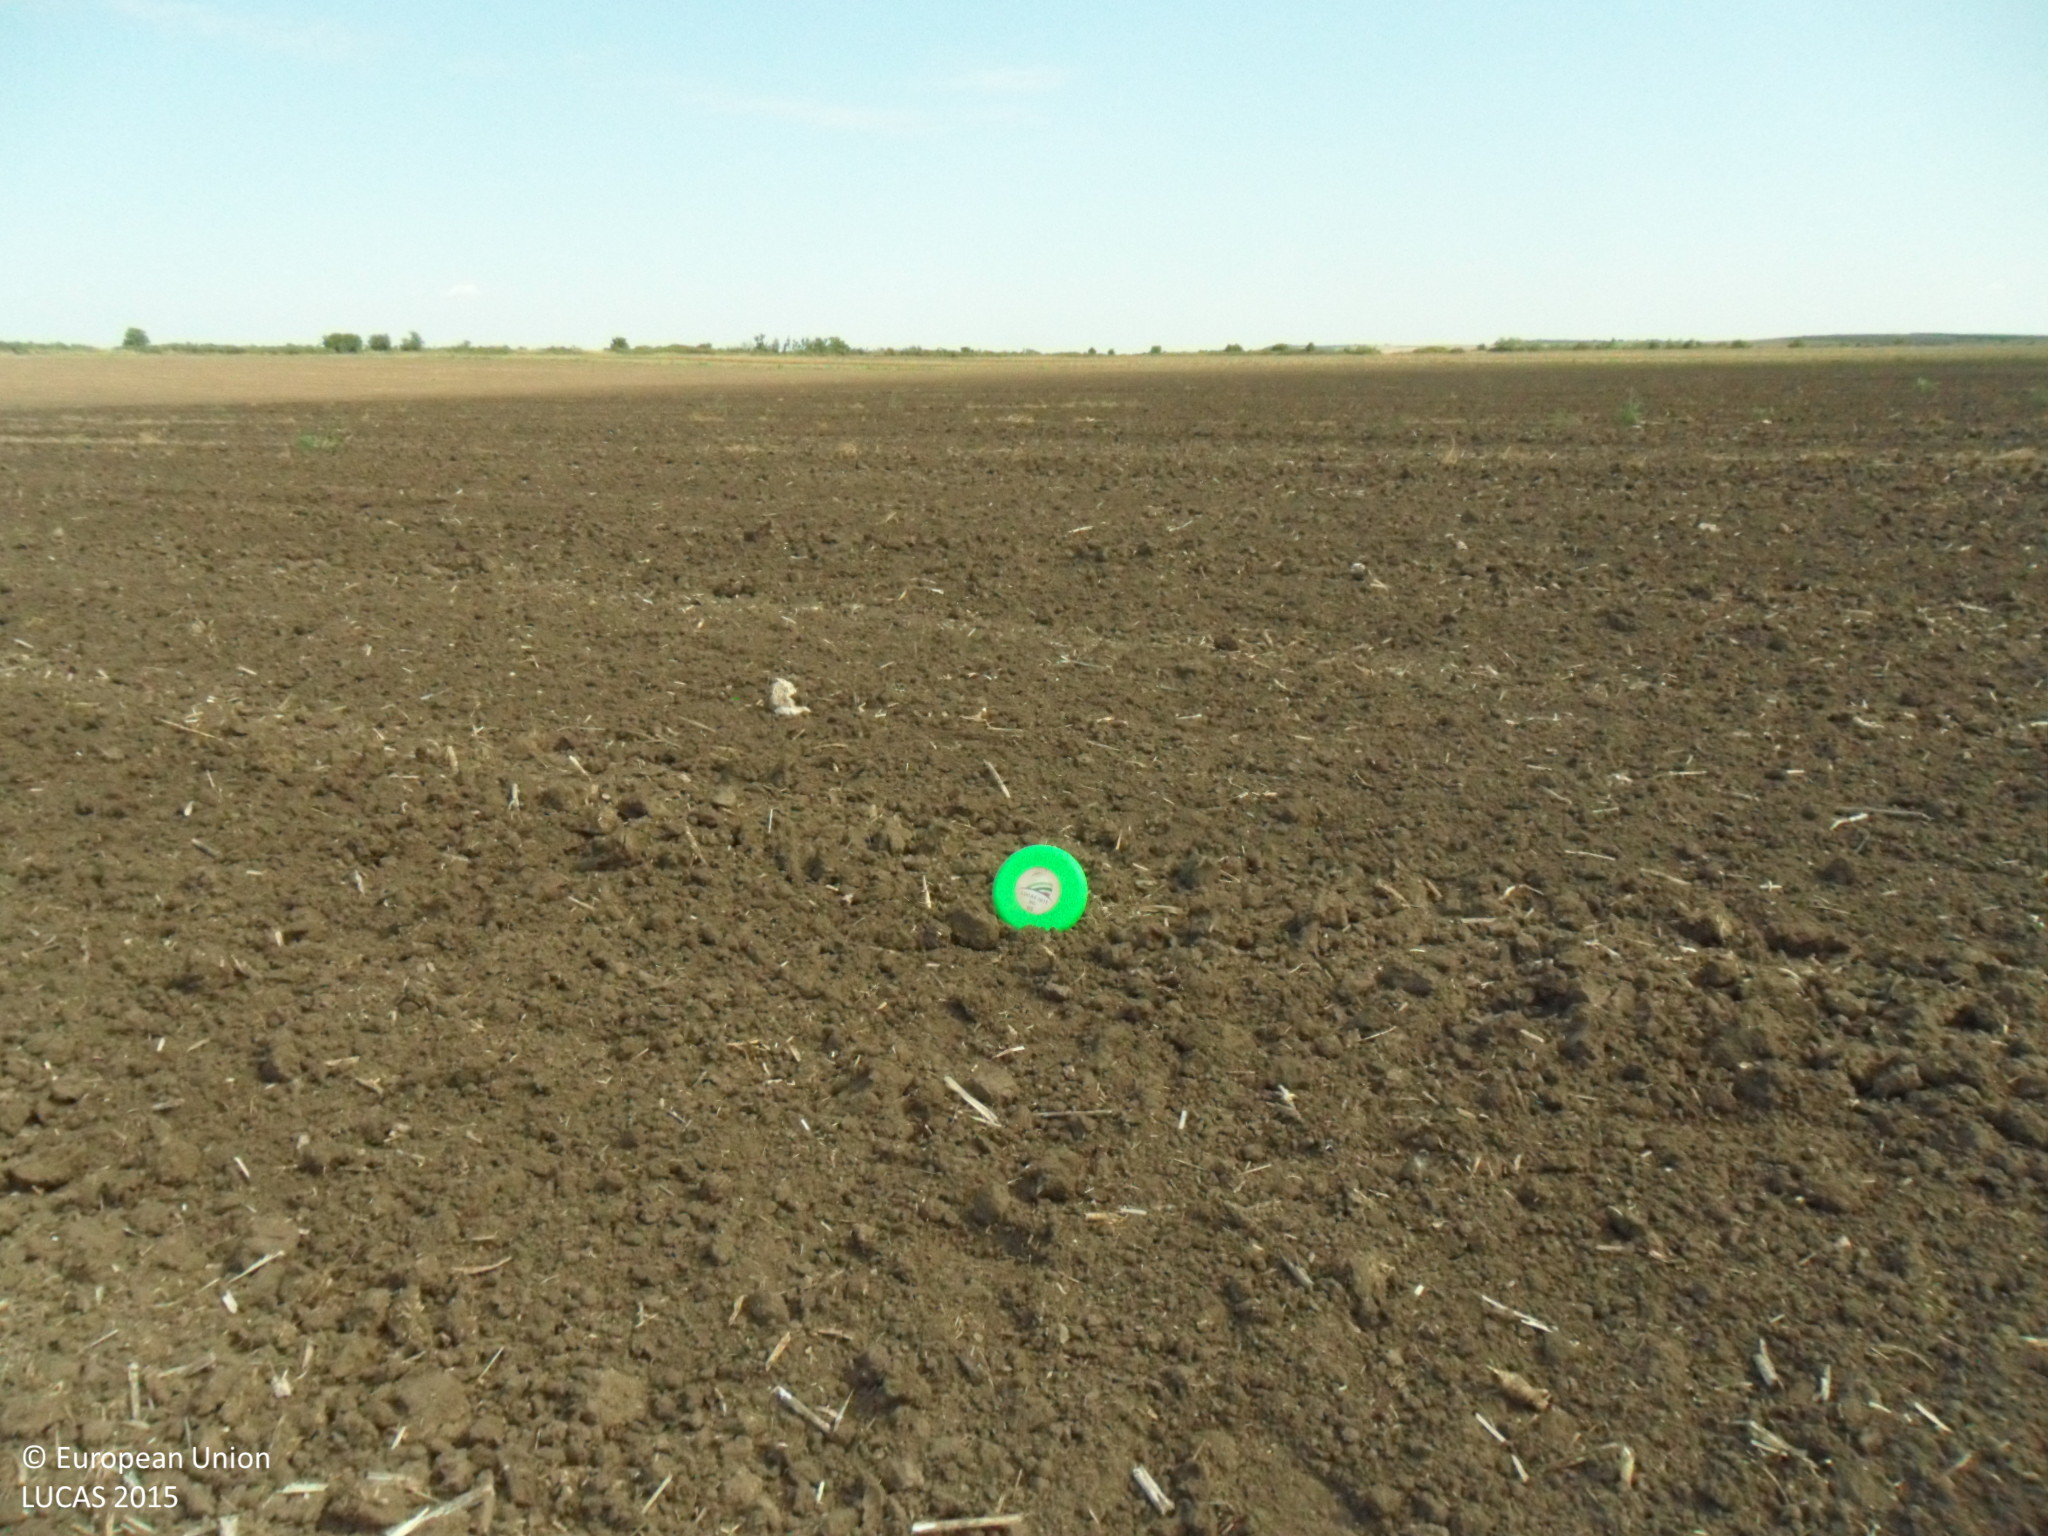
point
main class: Cropland
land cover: Sunflower
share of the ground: < 10 %
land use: Agriculture (excluding fallow land and kitchen gardens)
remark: Harvested field
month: September
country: BG
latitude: 43.9468
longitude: 26.4430
